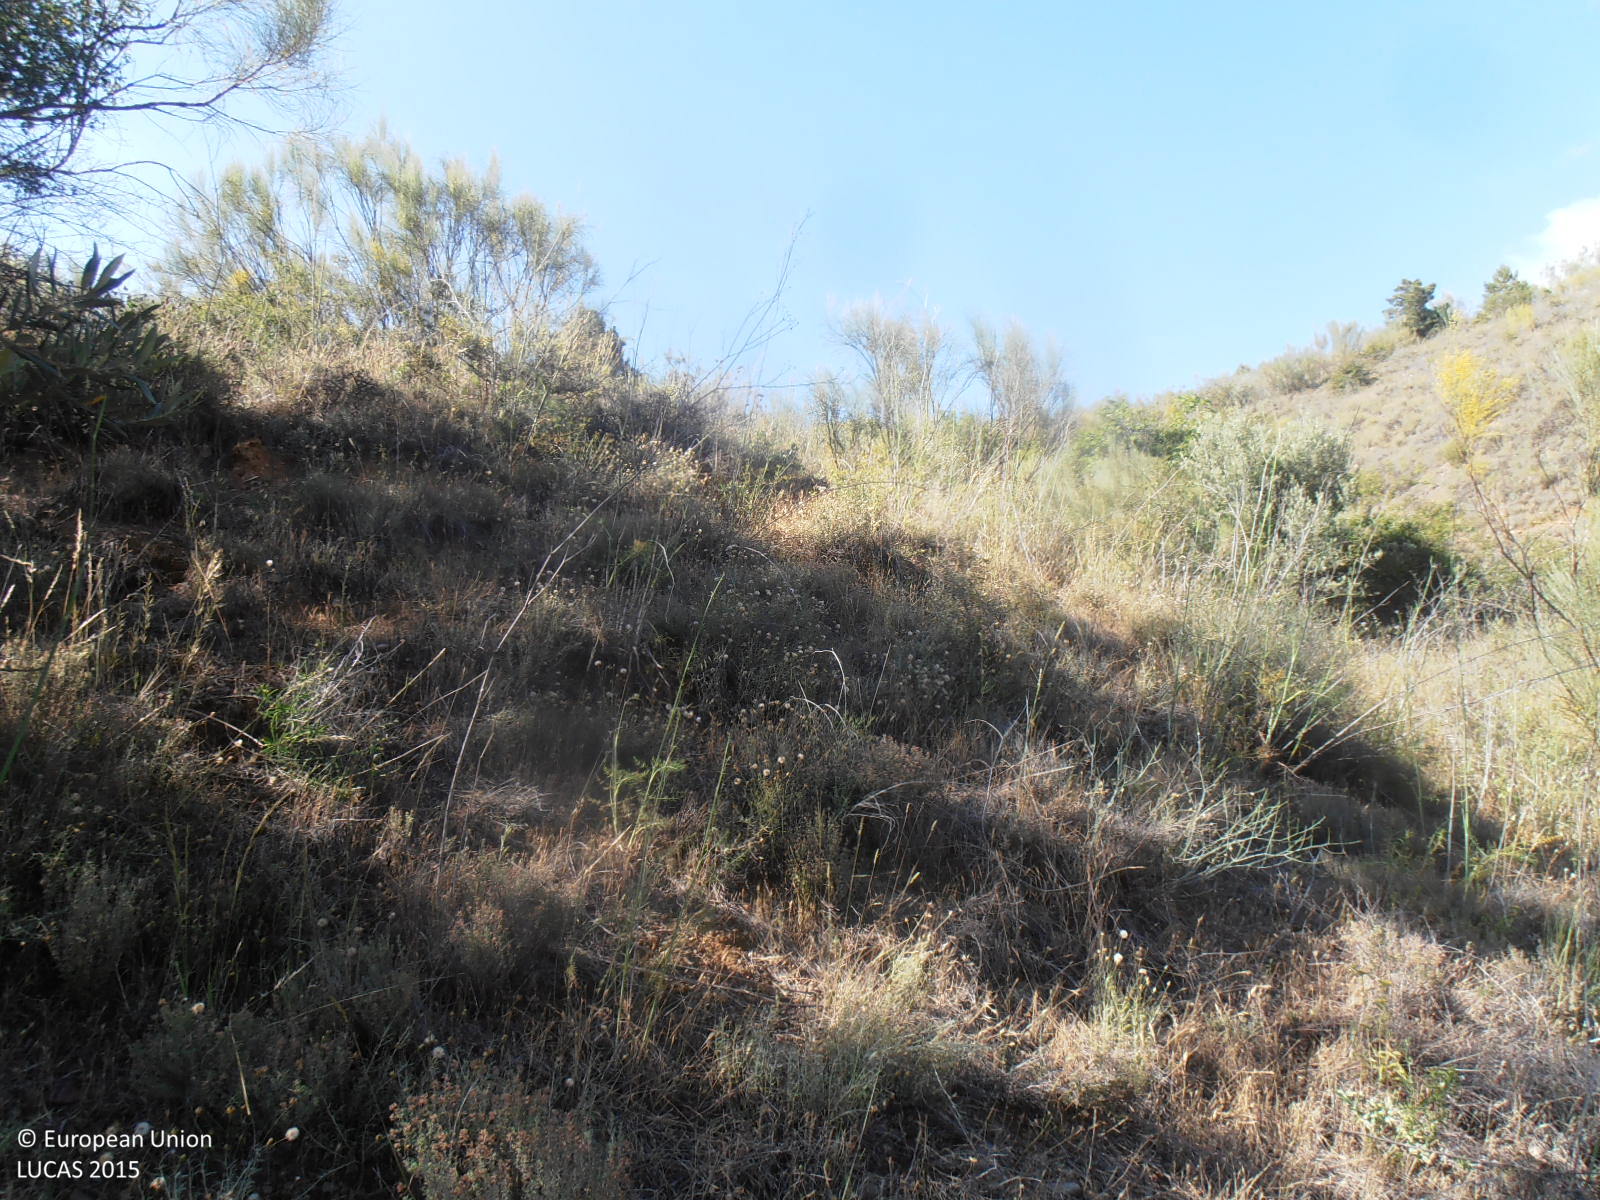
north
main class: Shrubland
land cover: Shrubland without tree cover
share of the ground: > 75 %
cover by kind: shrubs 100 %
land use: Abandoned areas
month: June
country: ES
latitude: 41.3532
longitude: -1.3899
